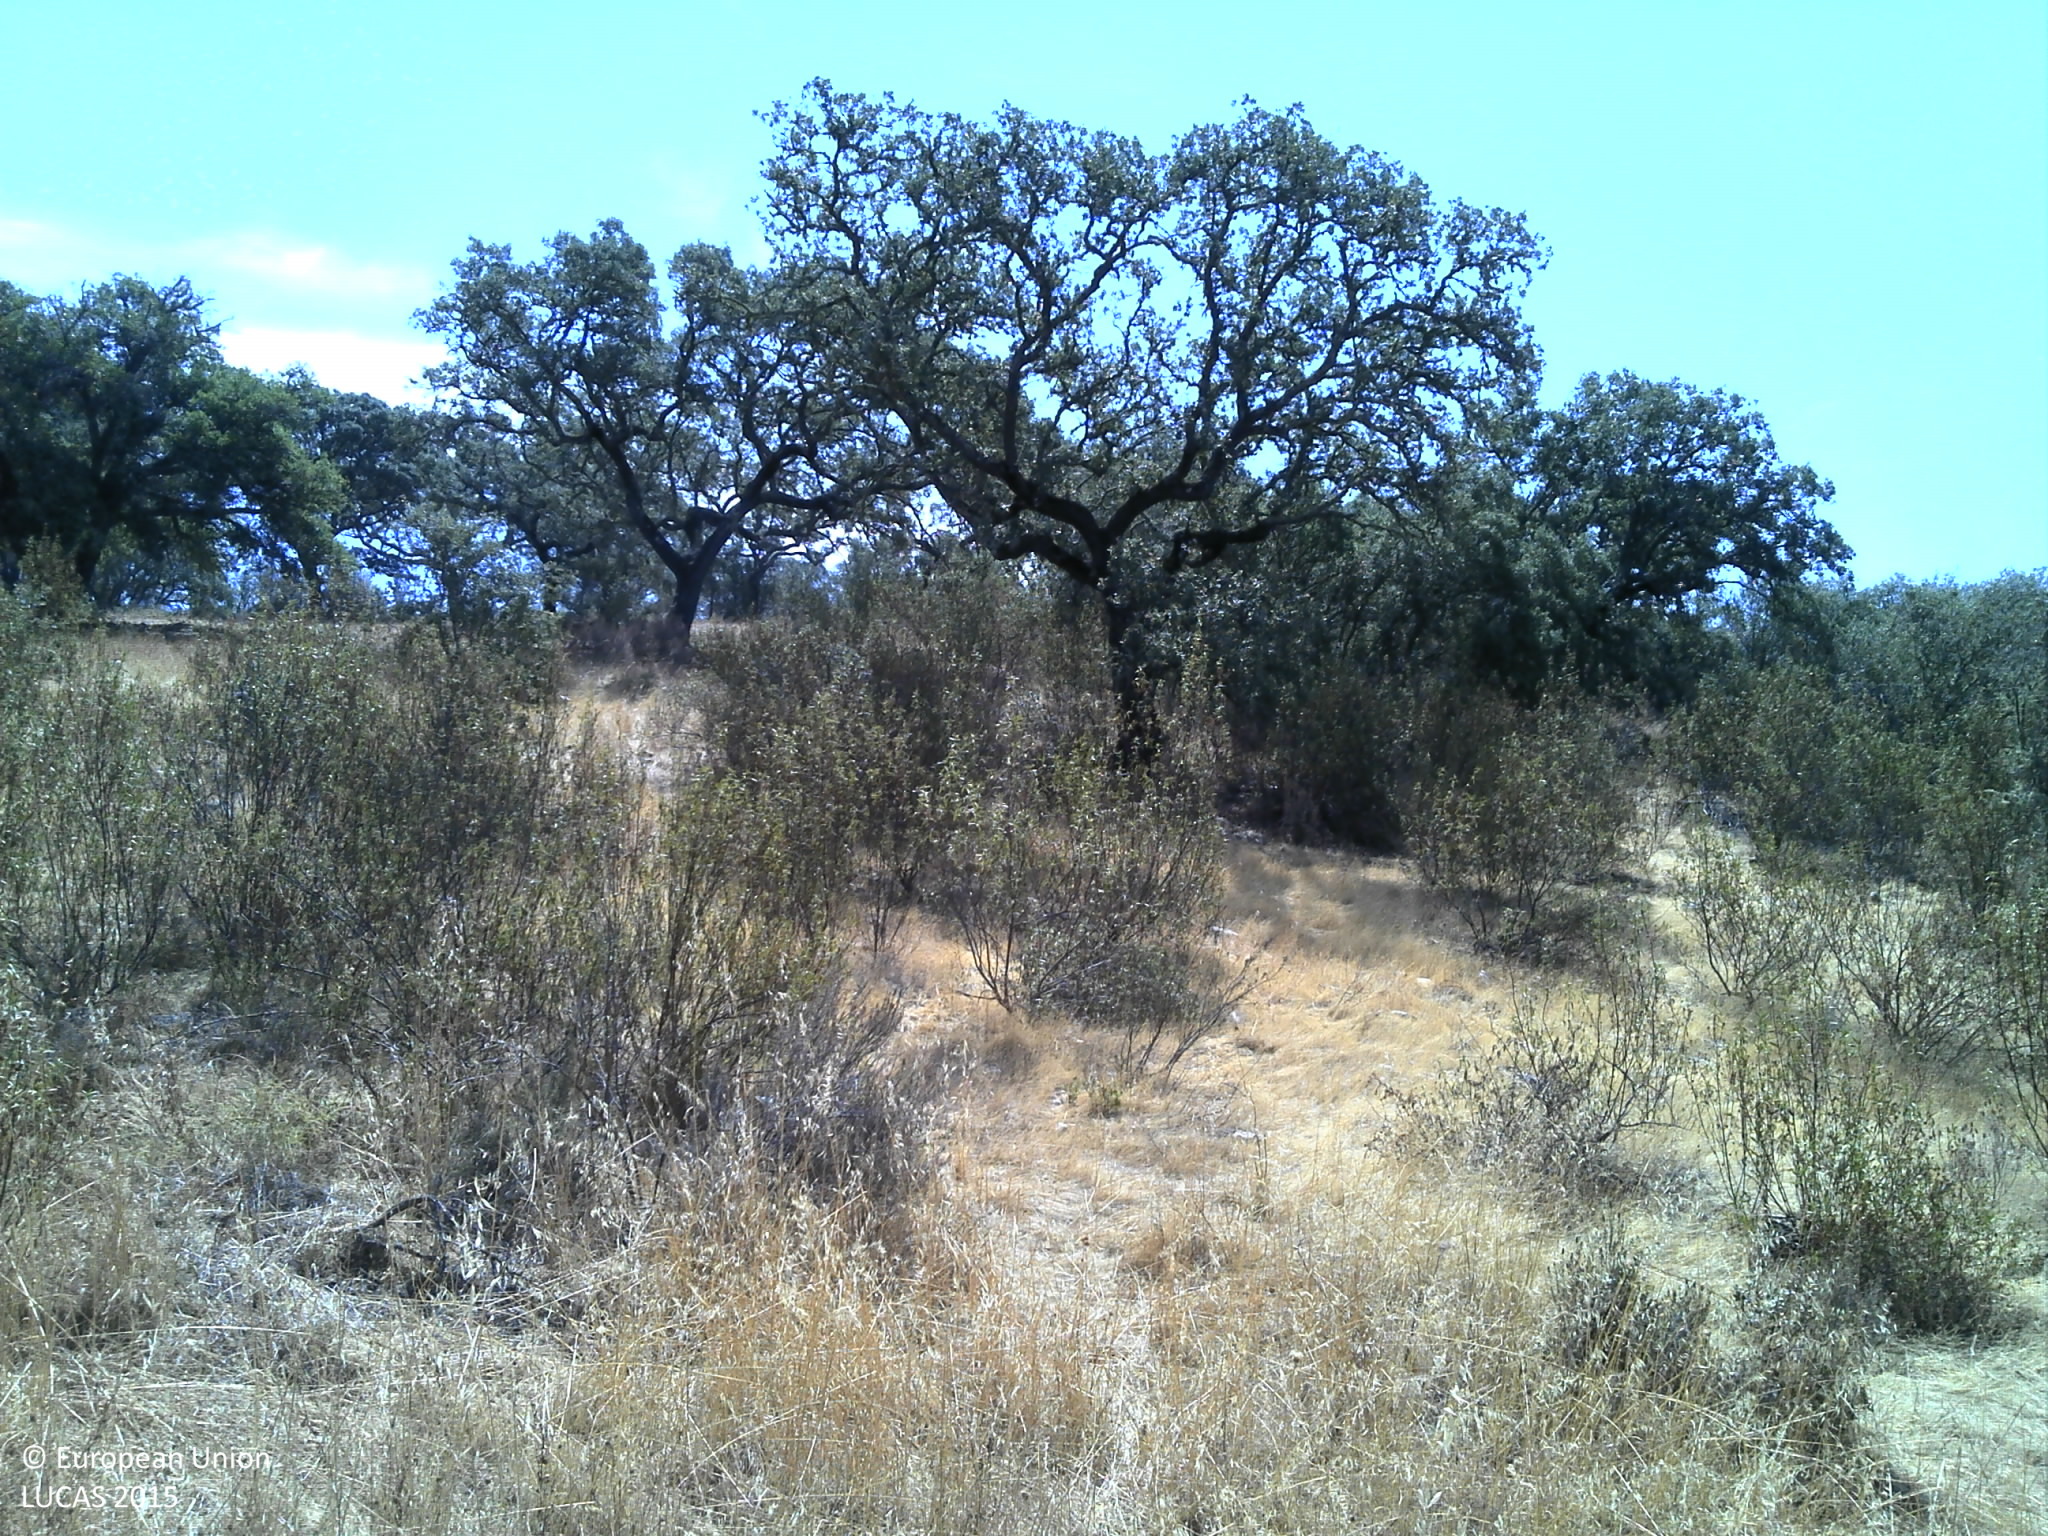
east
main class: Grassland
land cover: Grassland without tree/shrub cover
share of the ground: 25 - 50 %
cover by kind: unconsolidated bare surface 65 %, herbaceous plants 30 %, shrubs 5 %
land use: Agriculture (excluding fallow land and kitchen gardens)
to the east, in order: Grassland without tree/shrub cover; Broadleaved woodland; Tracks; Grass margins; Fences; Broadleaved woodland
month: July
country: PT
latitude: 38.5171
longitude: -7.6841
